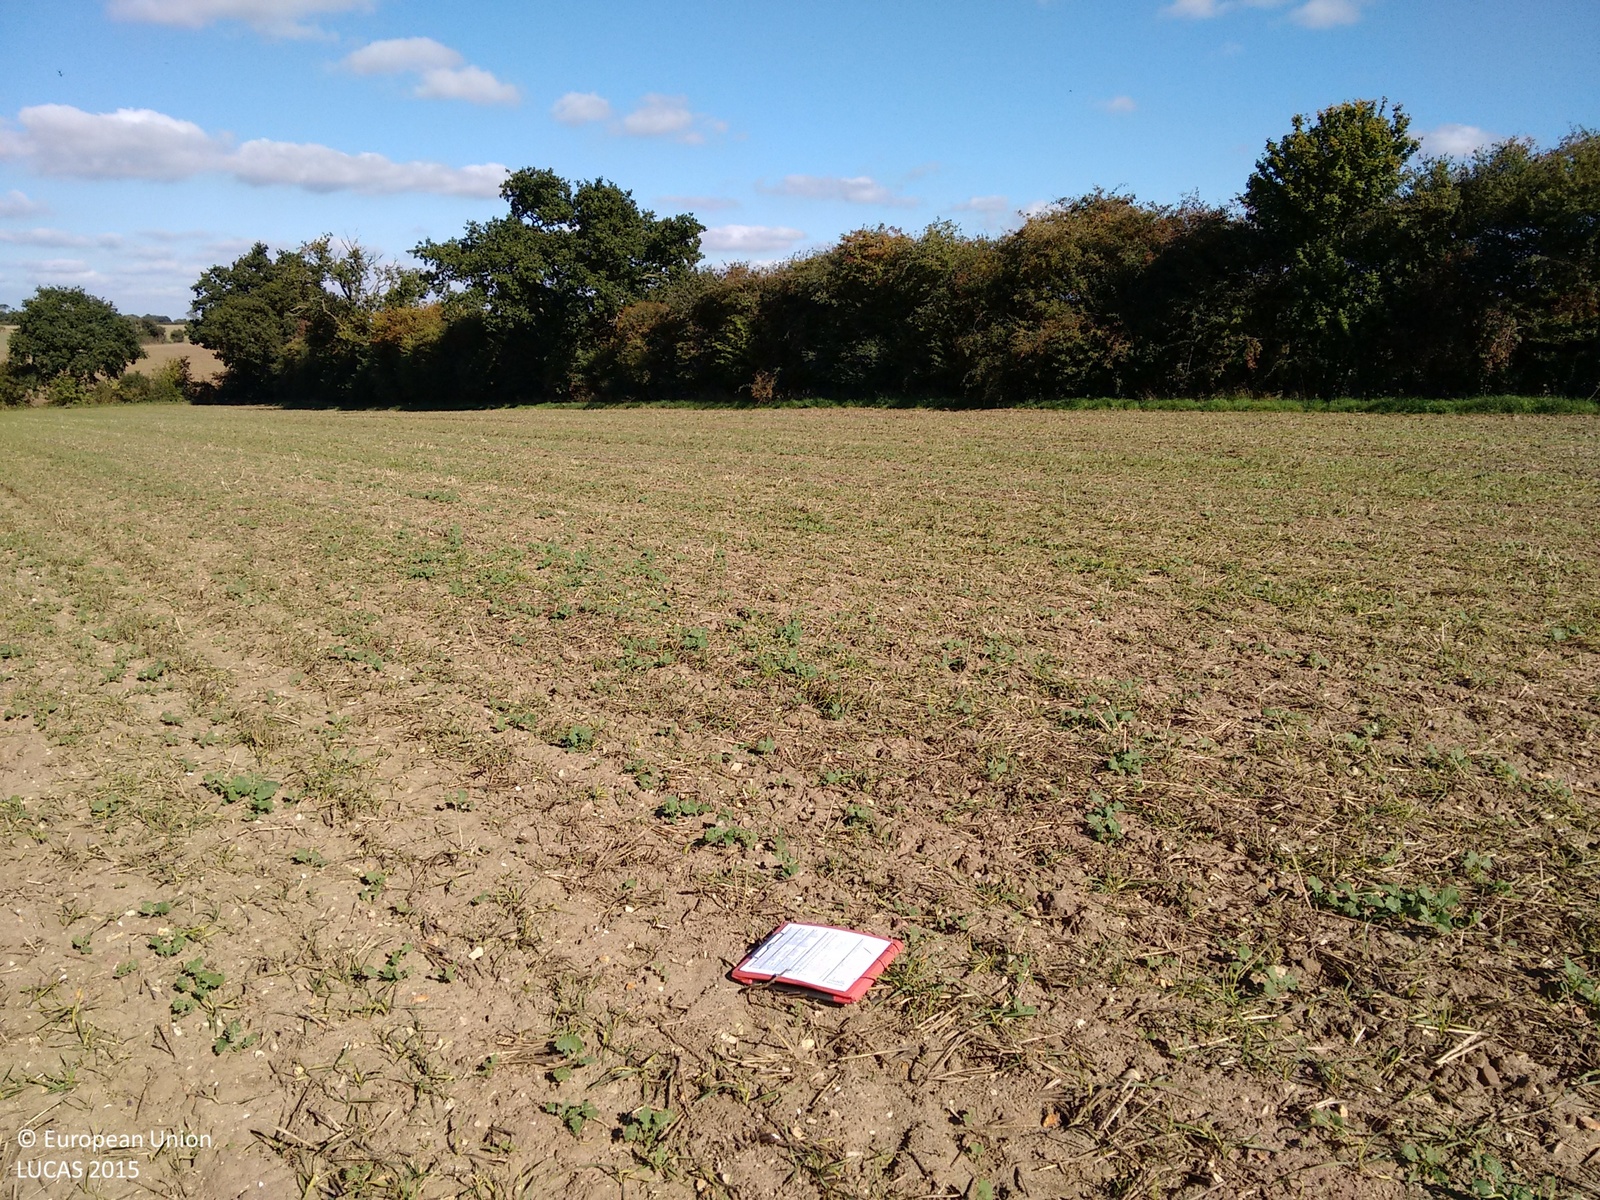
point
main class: Cropland
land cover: Rape and turnip rape
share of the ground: > 75 %
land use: Agriculture (excluding fallow land and kitchen gardens)
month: October
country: GB
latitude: 52.3494
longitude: 1.3327
